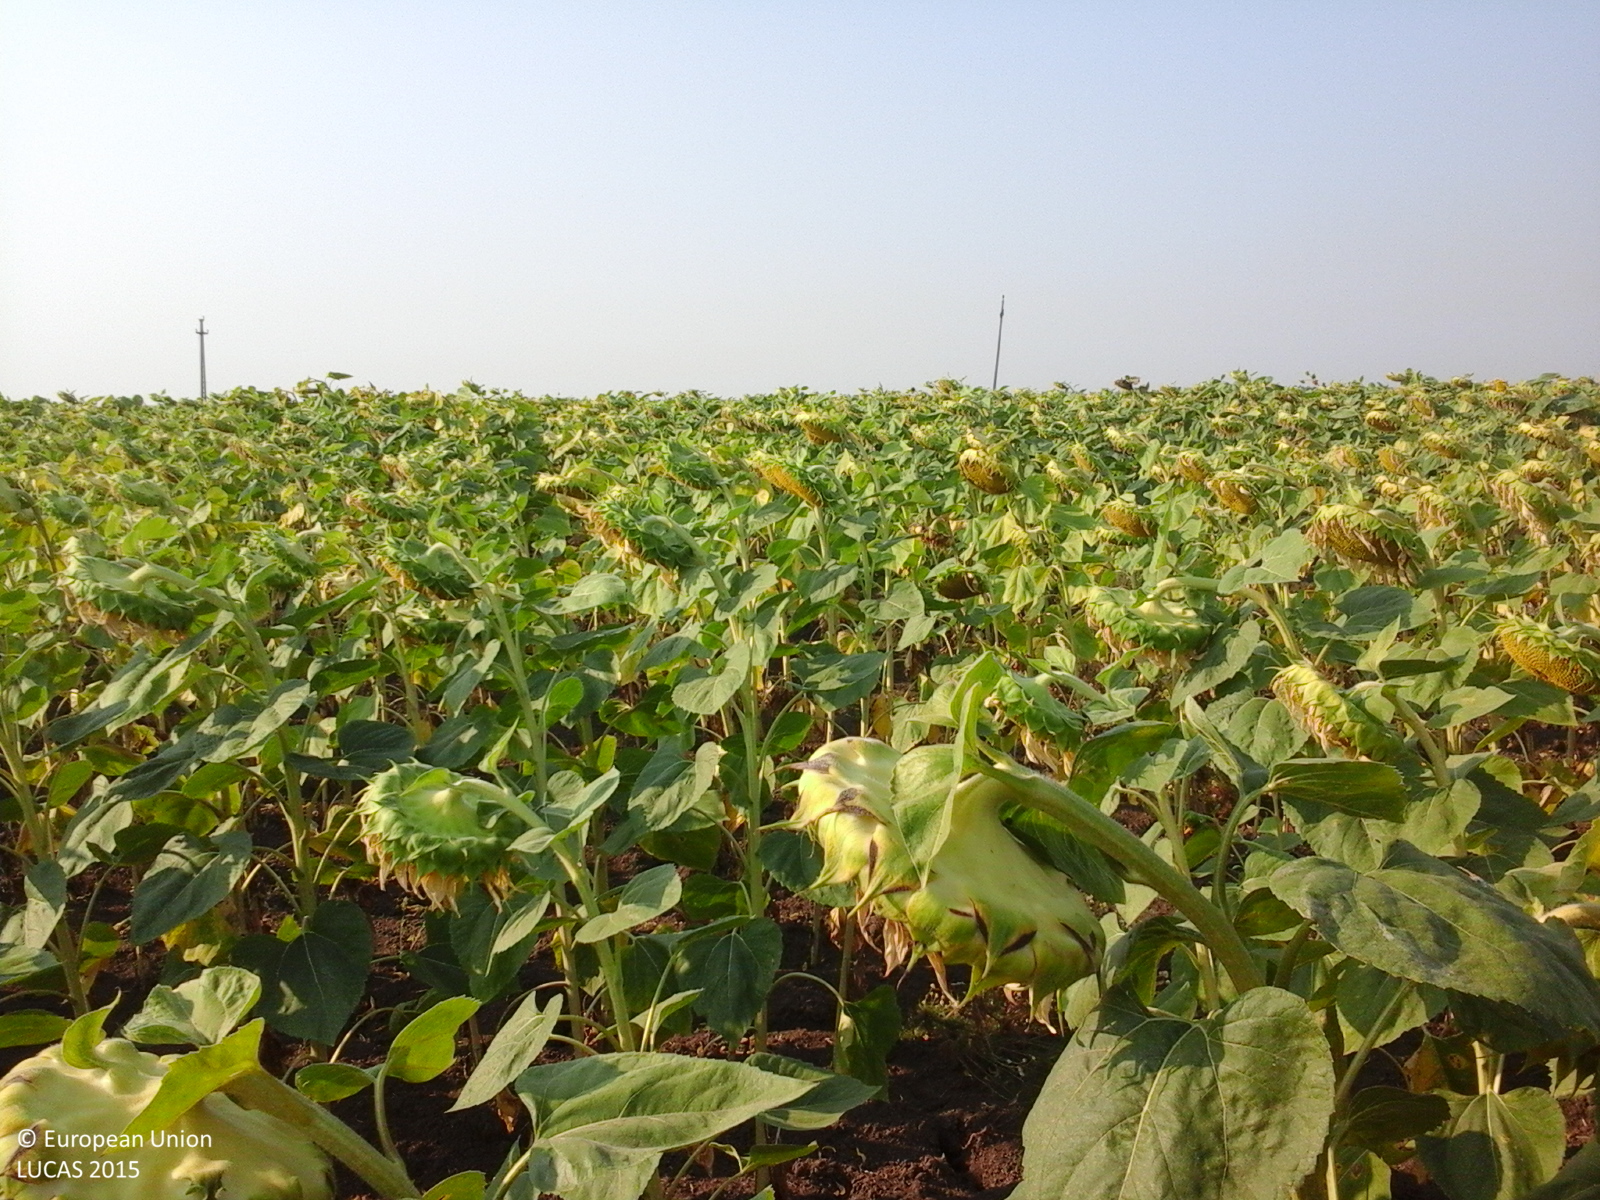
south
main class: Cropland
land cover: Sunflower
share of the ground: > 75 %
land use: Agriculture (excluding fallow land and kitchen gardens)
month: August
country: RO
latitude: 44.4244
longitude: 23.2756
